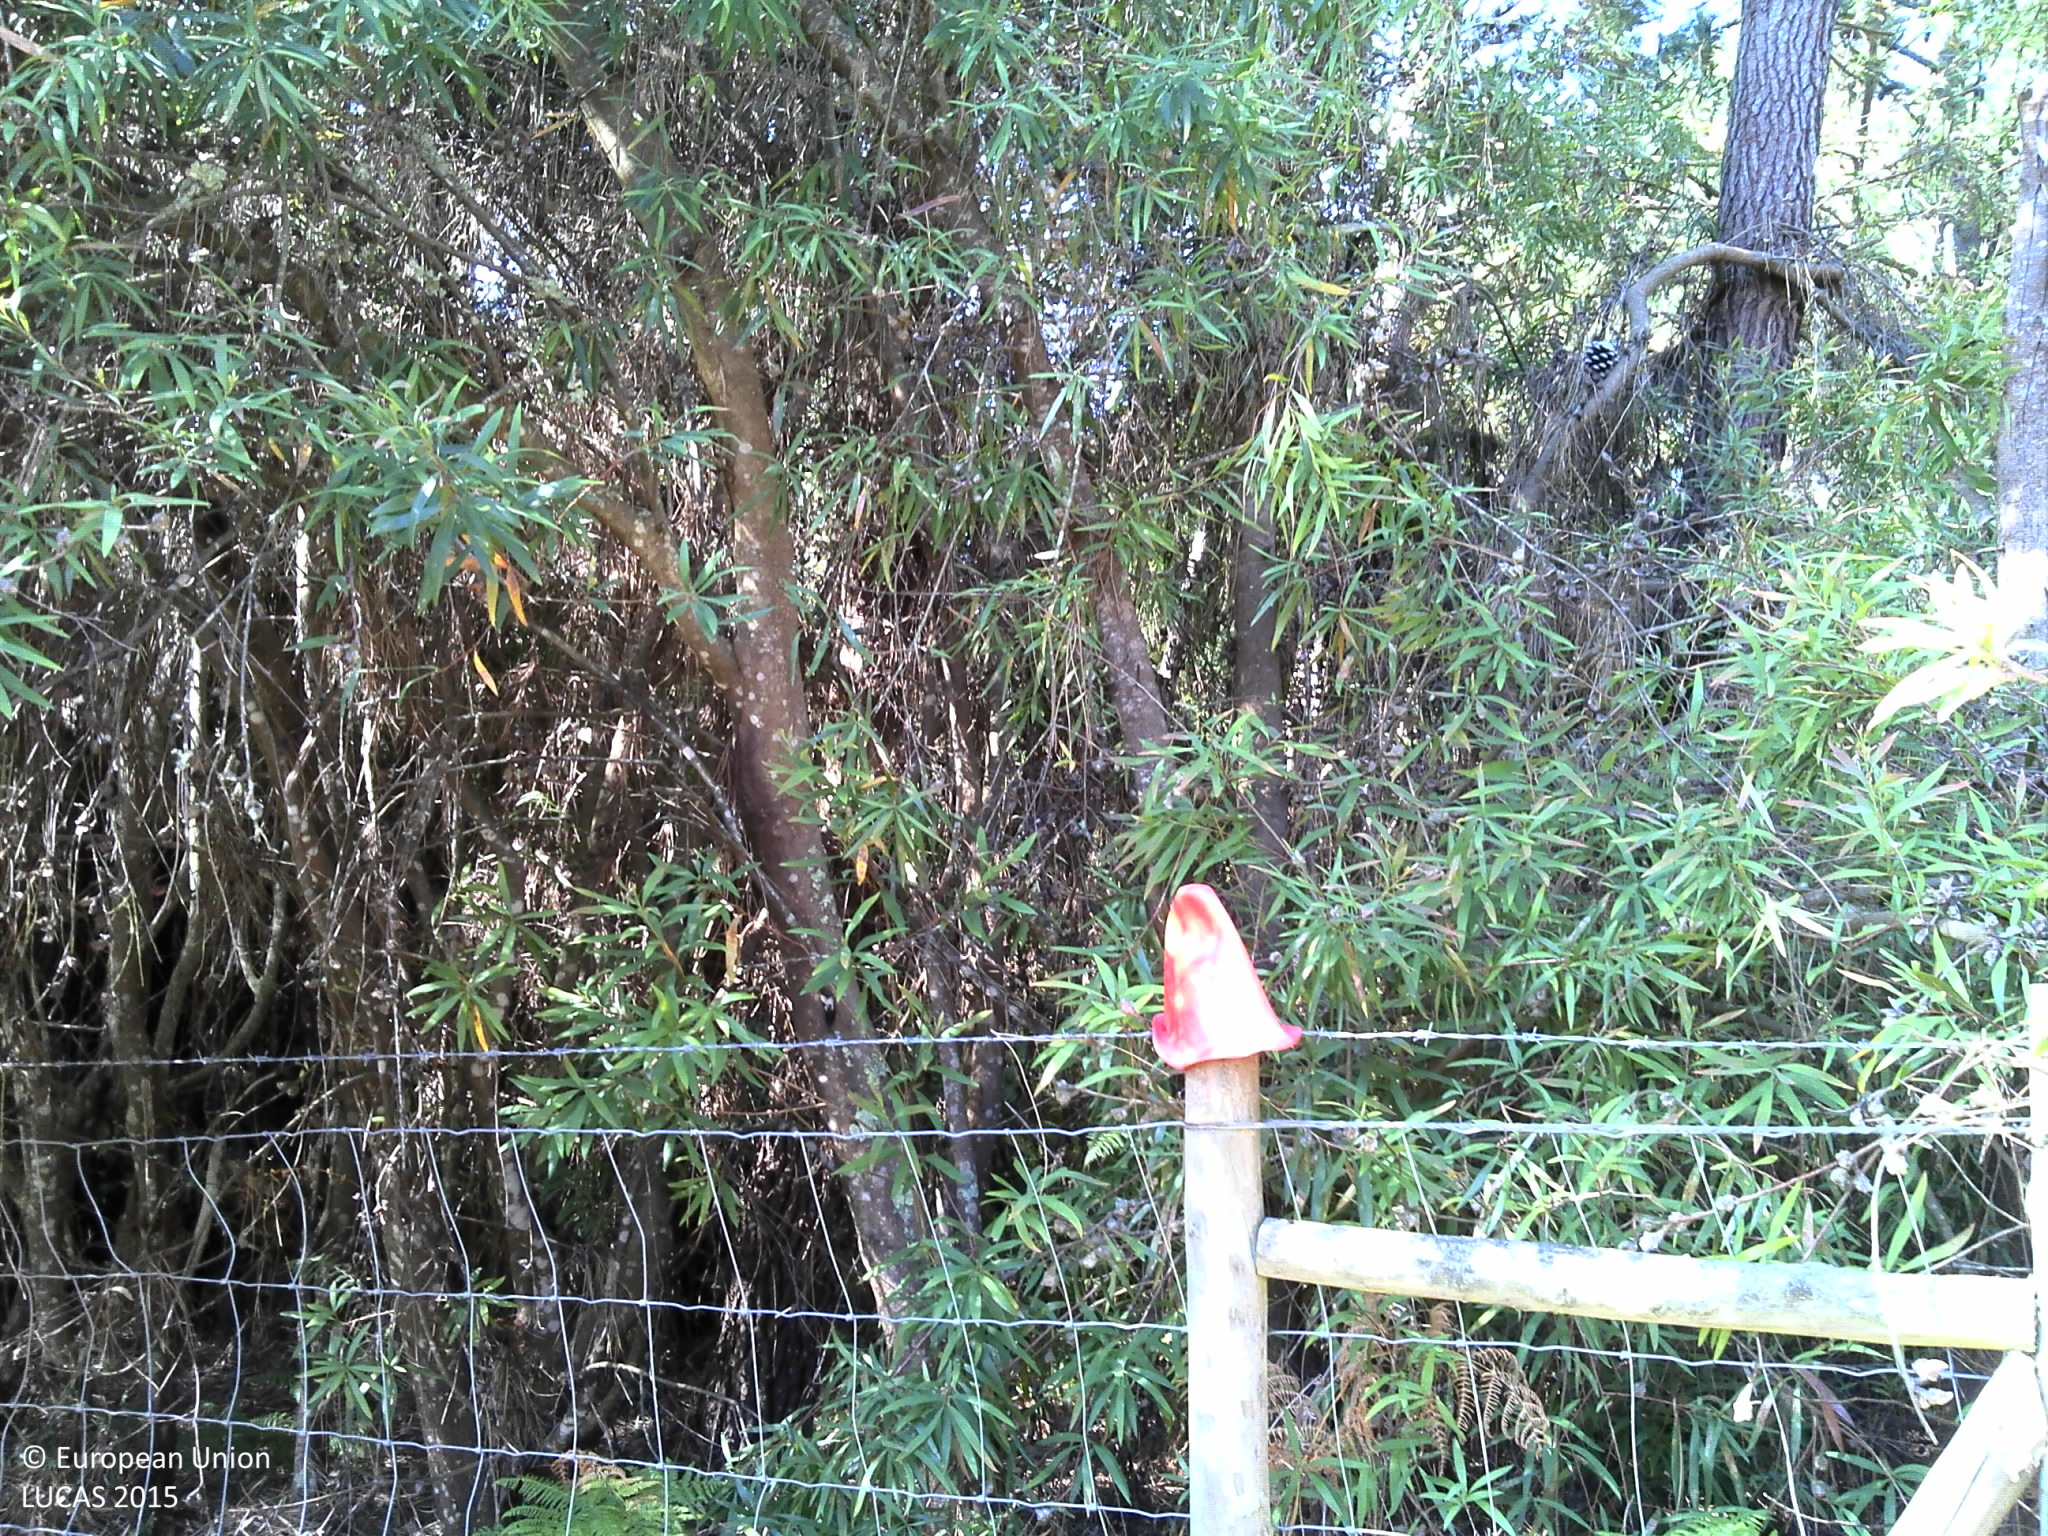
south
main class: Woodland
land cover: Pine dominated coniferous woodland
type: coniferous forest of the mediterranean region
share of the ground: 25 - 50 %
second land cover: Grassland without tree/shrub cover
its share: 25 - 50 %
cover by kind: coniferous forest trees 35 %, herbaceous plants 30 %, unconsolidated bare surface 30 %, shrubs 5 %
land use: Forestry
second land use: Agriculture (excluding fallow land and kitchen gardens)
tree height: > 5 m
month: June
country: PT
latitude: 37.3762
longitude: -8.7947
